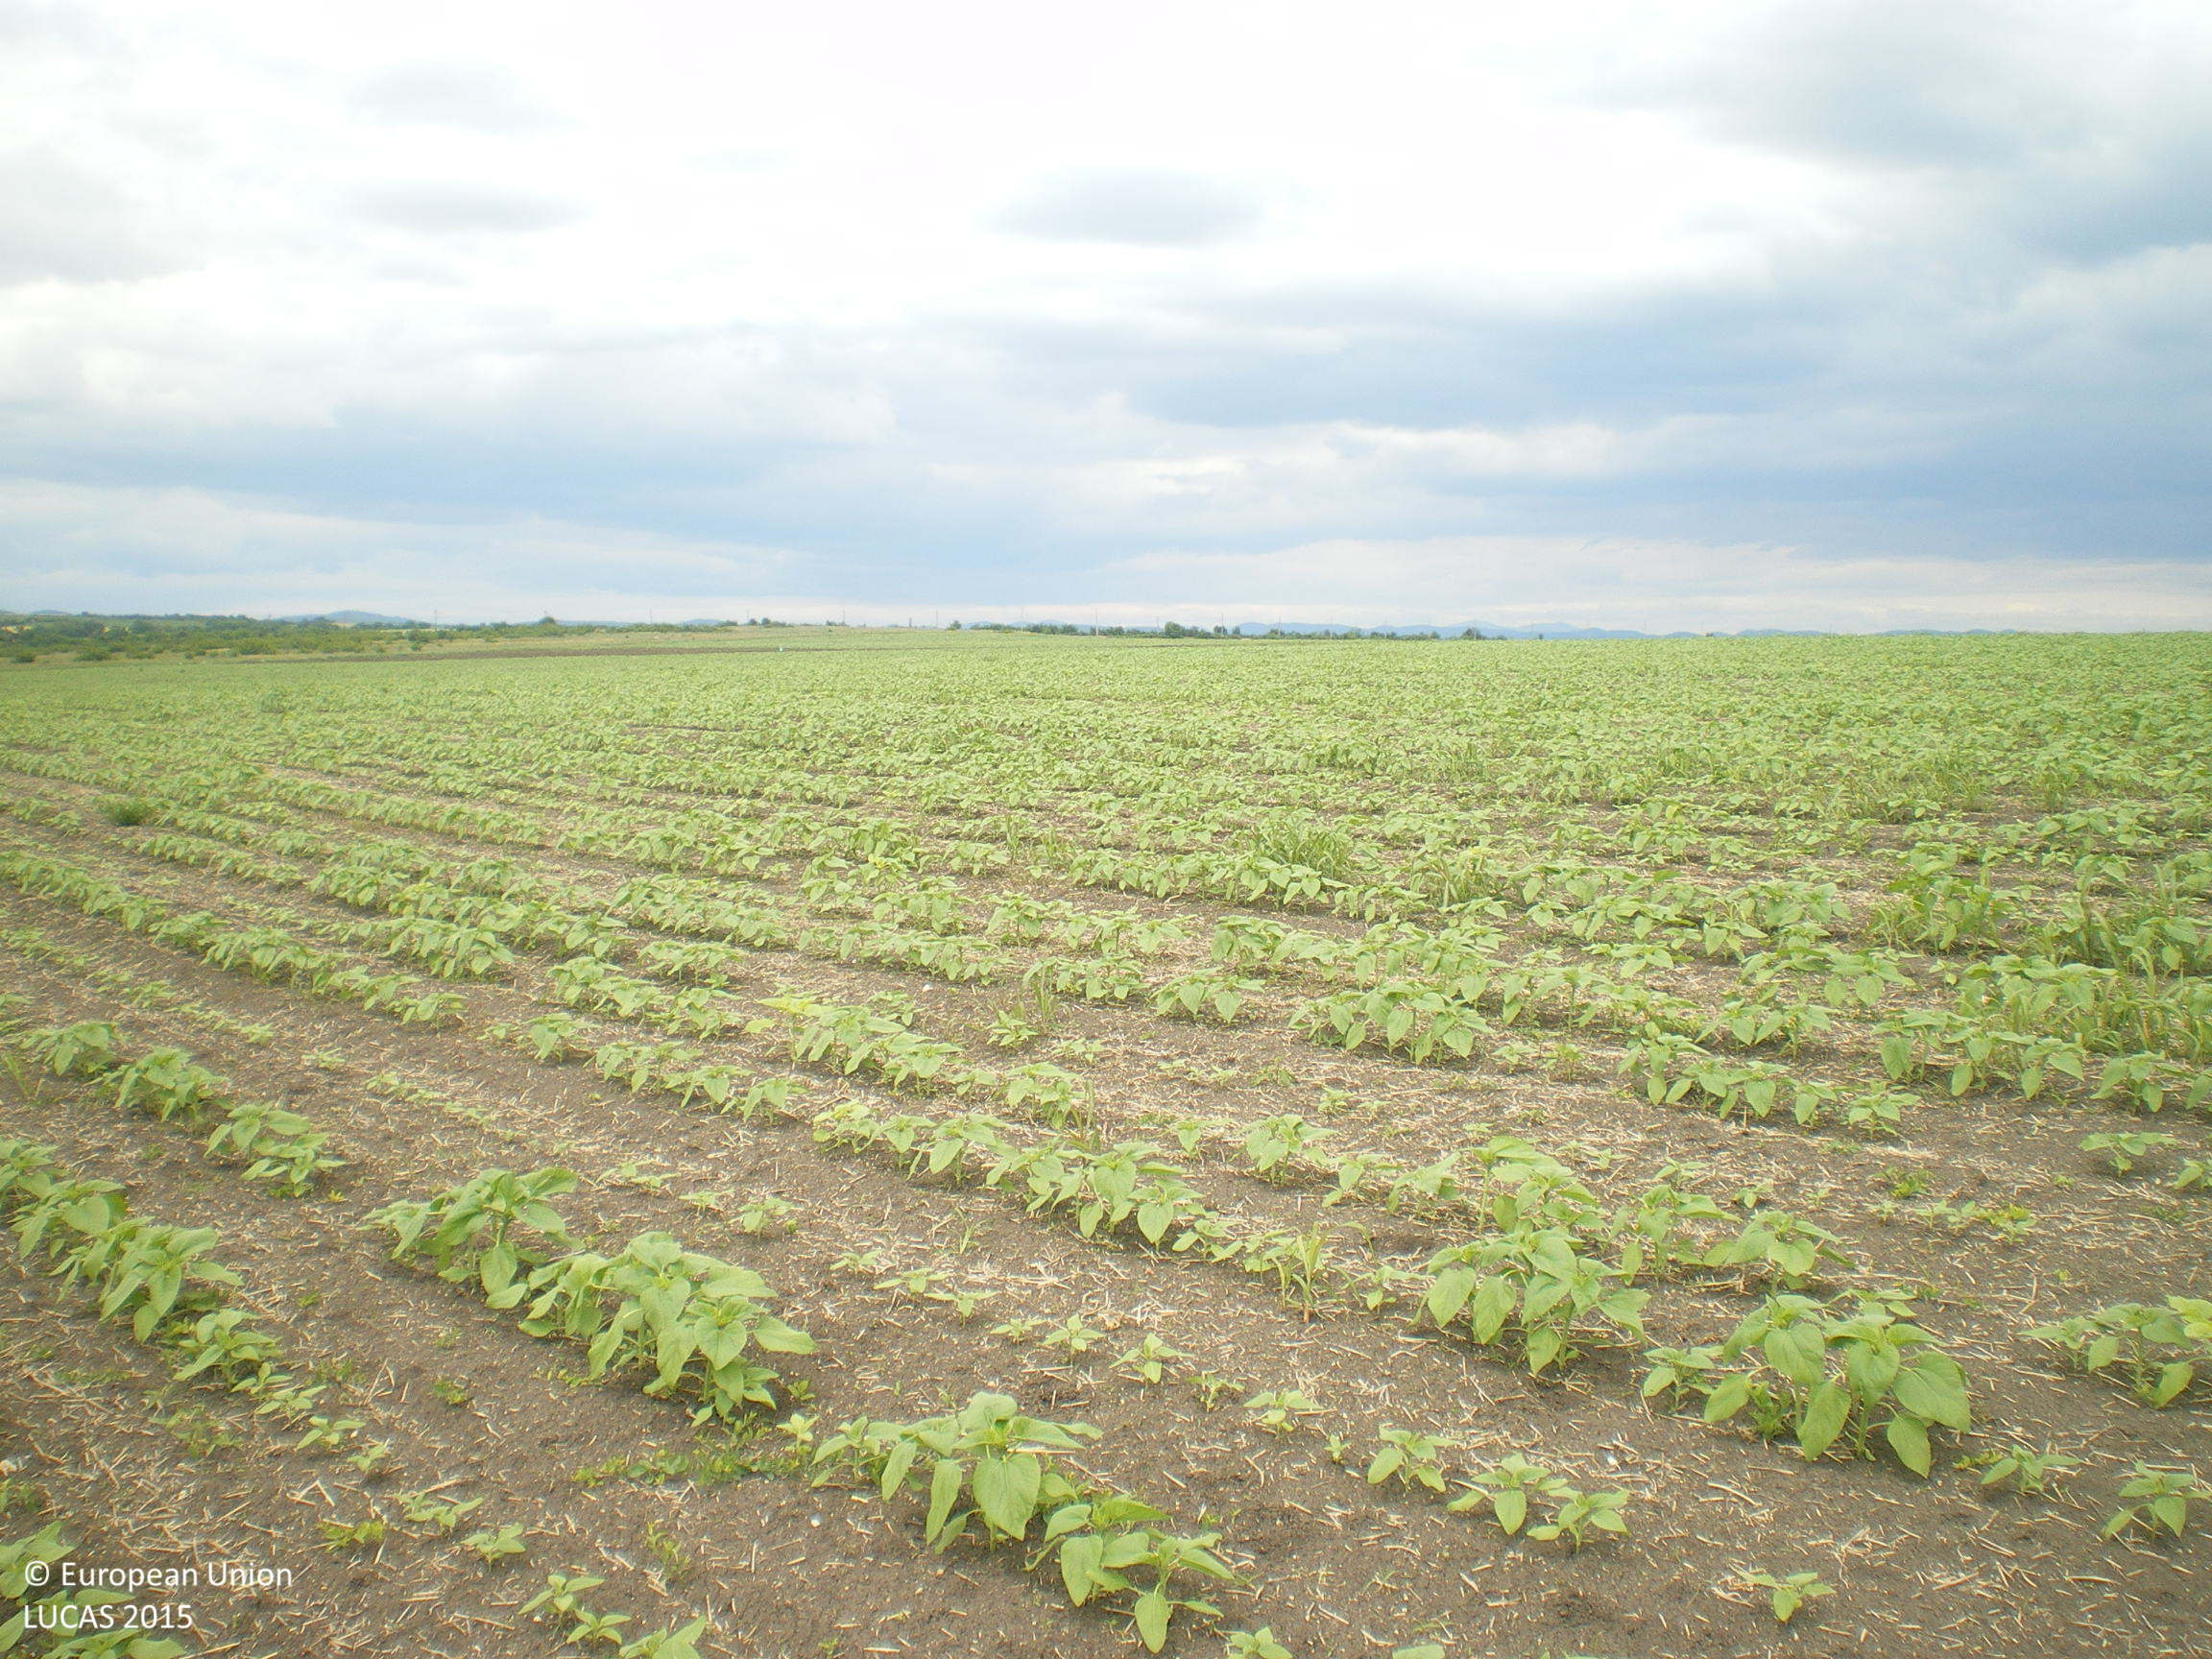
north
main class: Cropland
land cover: Sunflower
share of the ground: 10 - 25 %
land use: Agriculture (excluding fallow land and kitchen gardens)
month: May
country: BG
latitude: 42.2323
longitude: 25.4421
